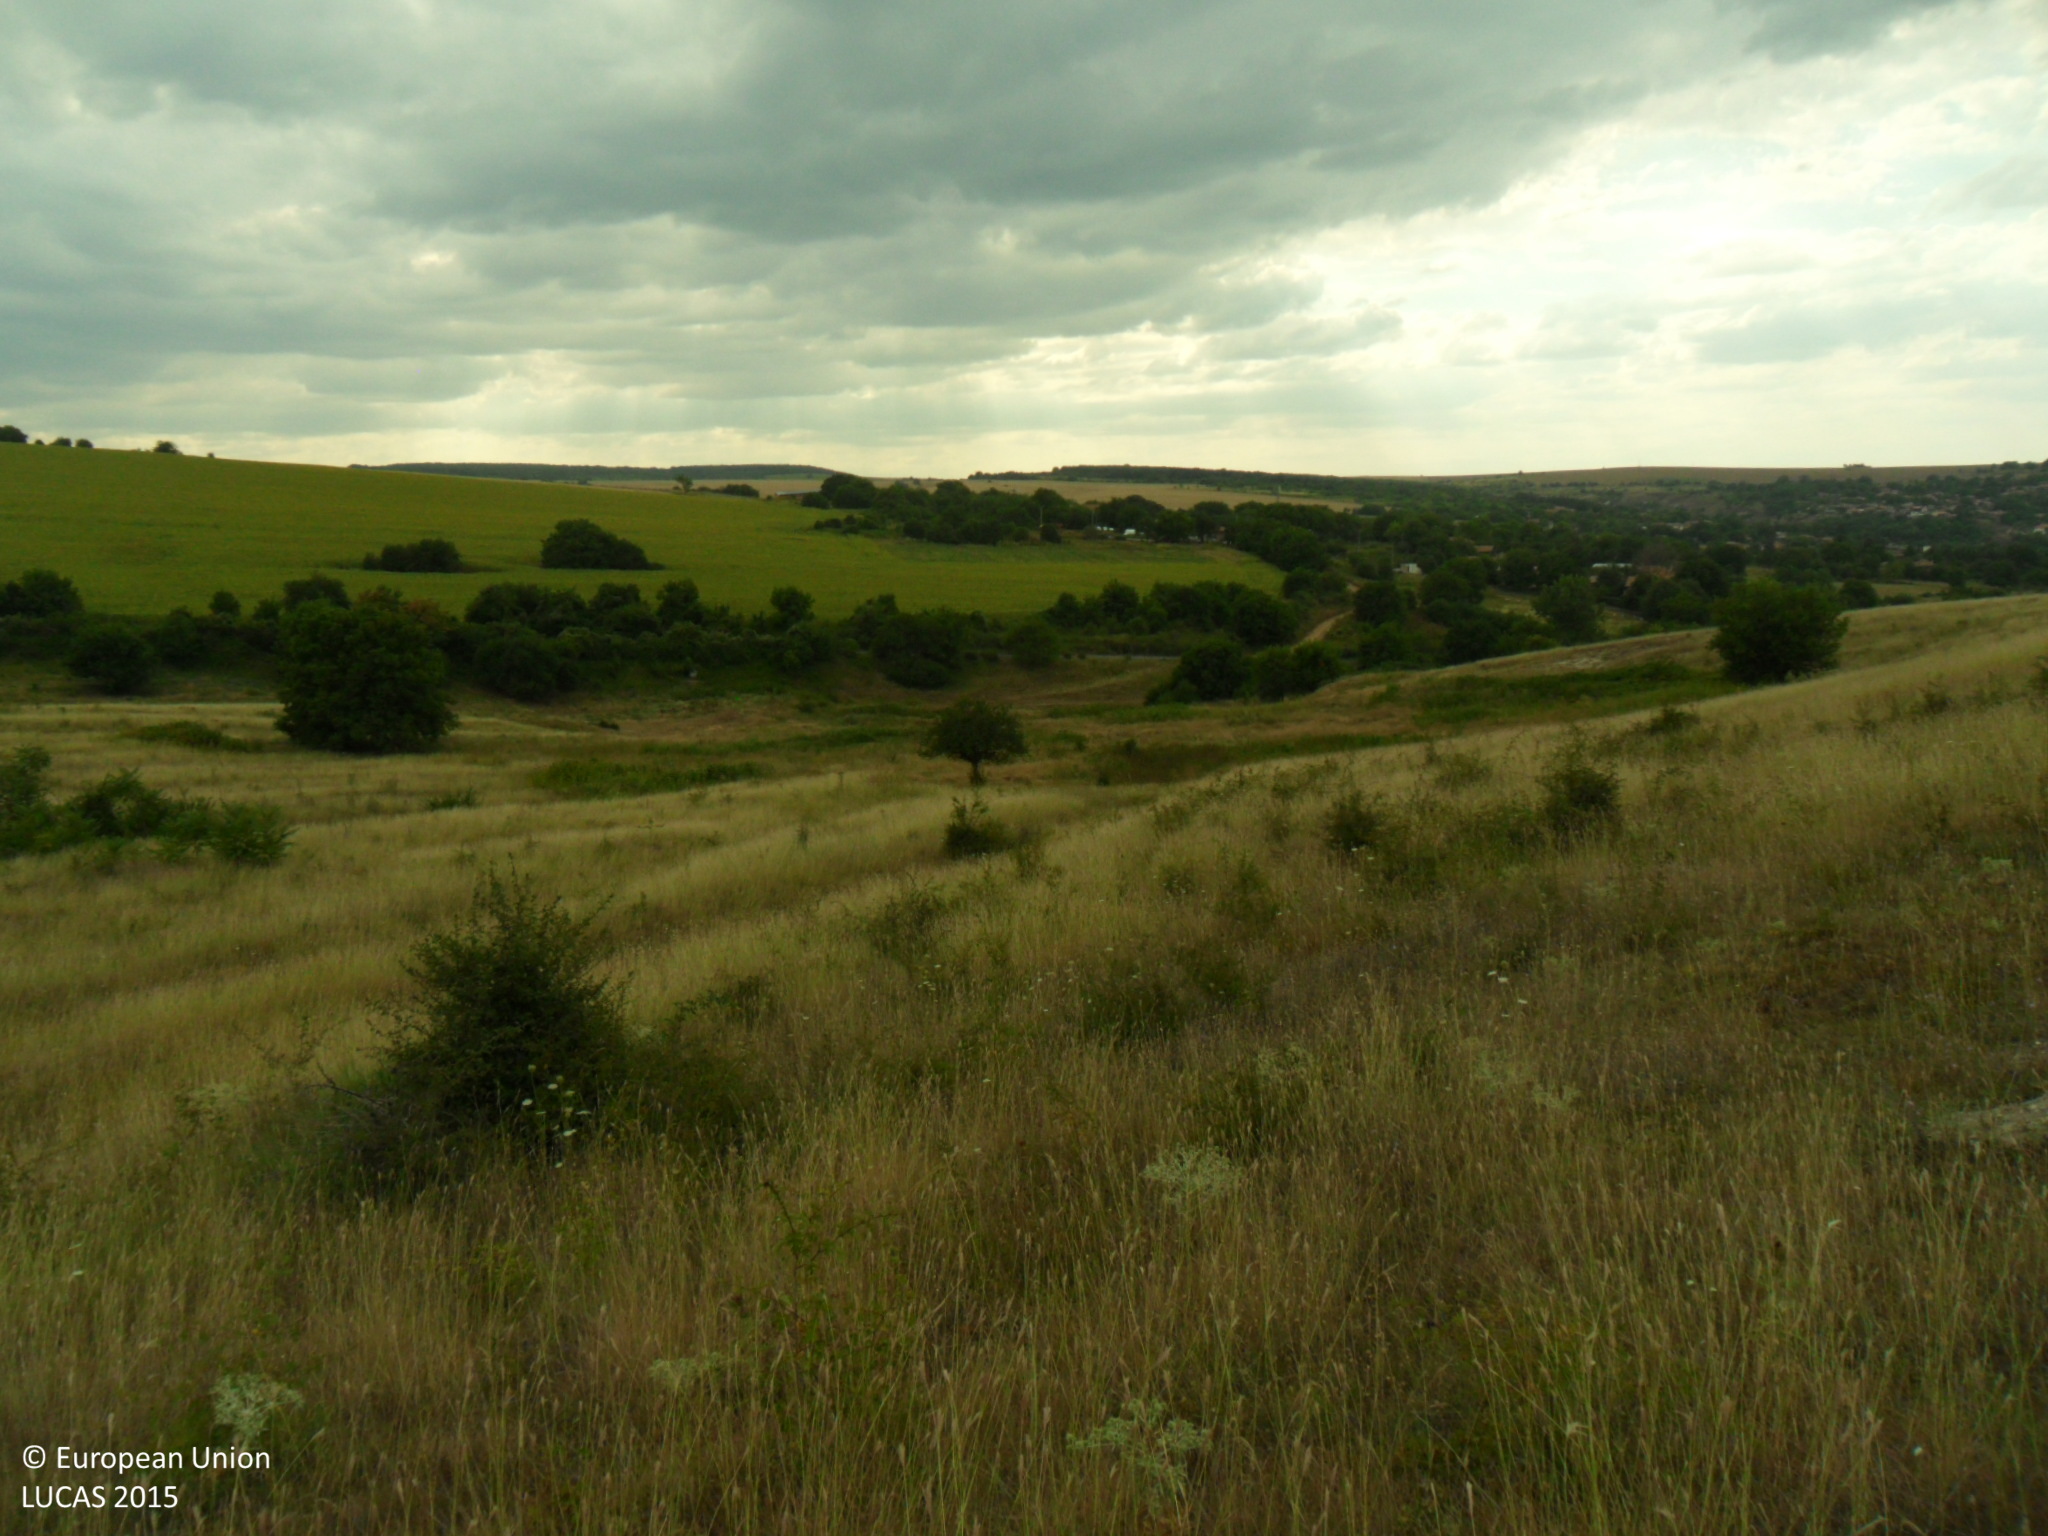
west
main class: Grassland
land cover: Grassland with sparse tree/shrub cover
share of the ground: > 75 %
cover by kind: herbaceous plants 90 %, broadleaved forest trees 5 %, shrubs 5 %
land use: Agriculture (excluding fallow land and kitchen gardens)
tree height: < 5 m
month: August
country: BG
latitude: 43.4822
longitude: 26.5876
